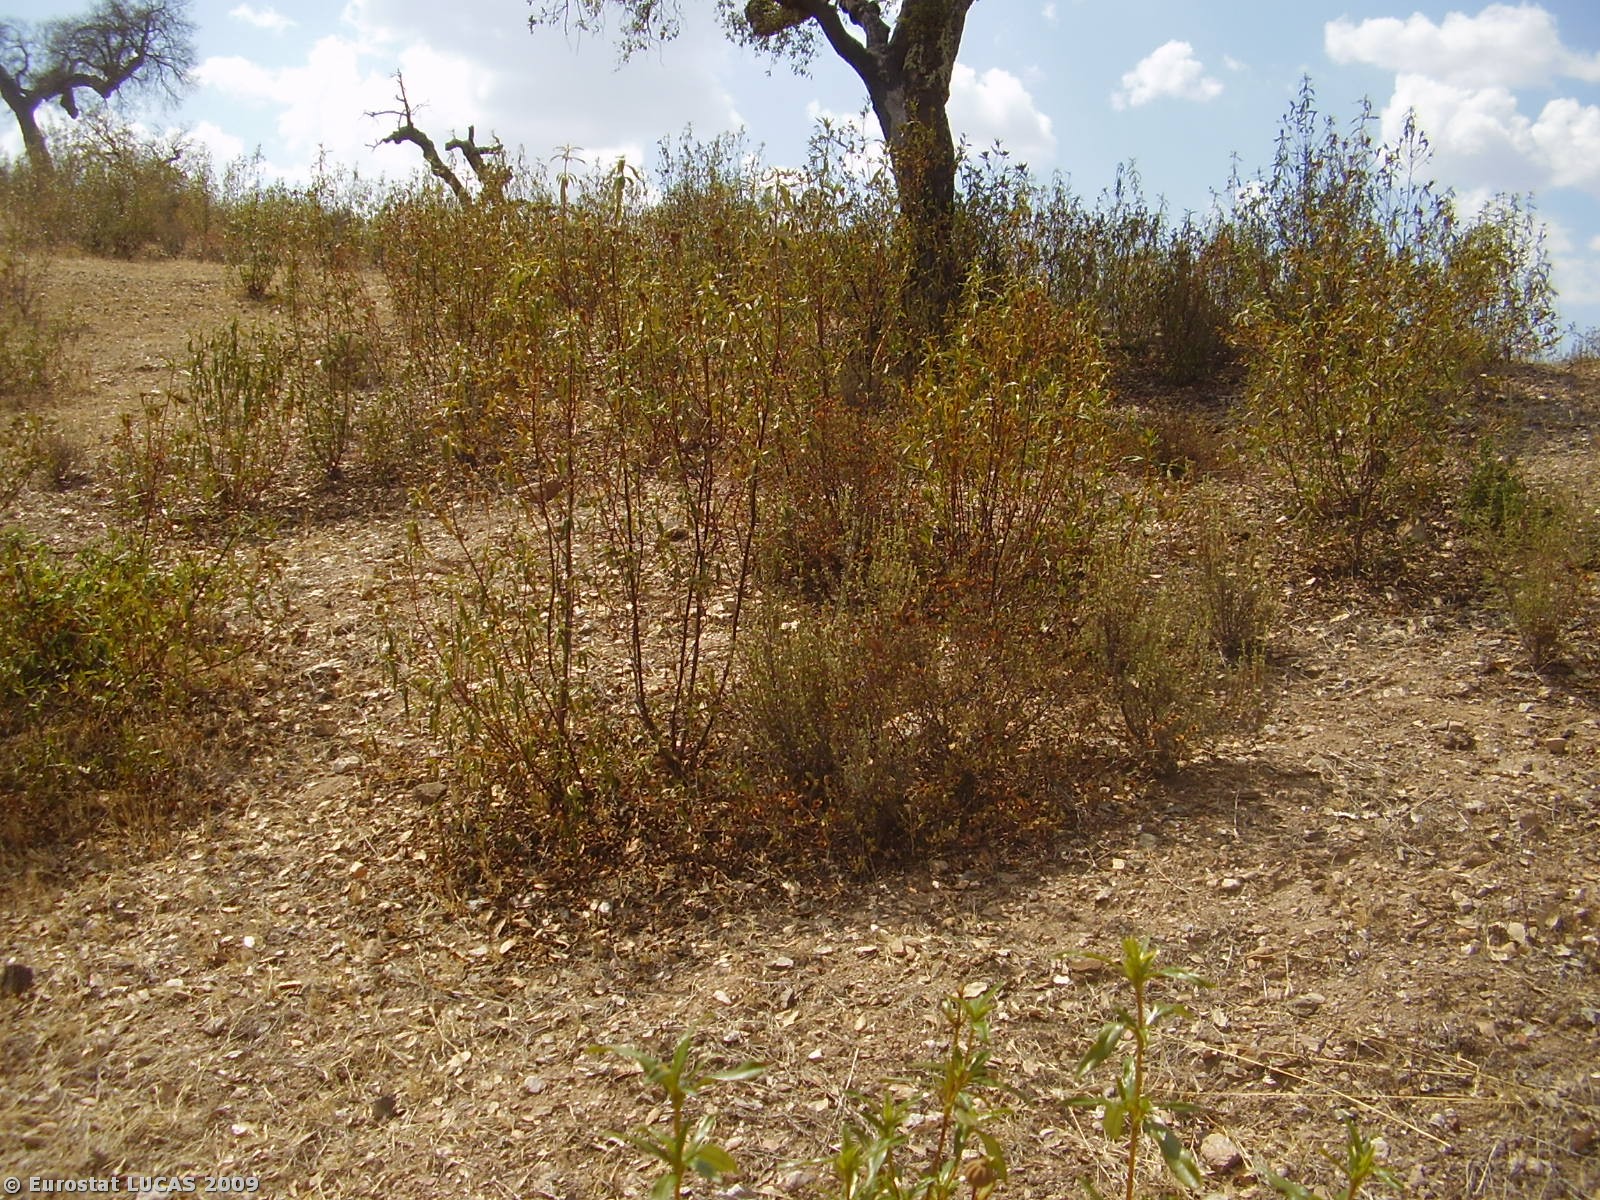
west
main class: Woodland
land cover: Broadleaved woodland
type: broadleaved evergreen forest
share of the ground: 10 - 25 %
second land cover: Bare land
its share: > 75 %
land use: Forestry
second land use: Fallow land
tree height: > 5 m
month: August
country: PT
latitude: 38.2556
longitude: -7.8948
